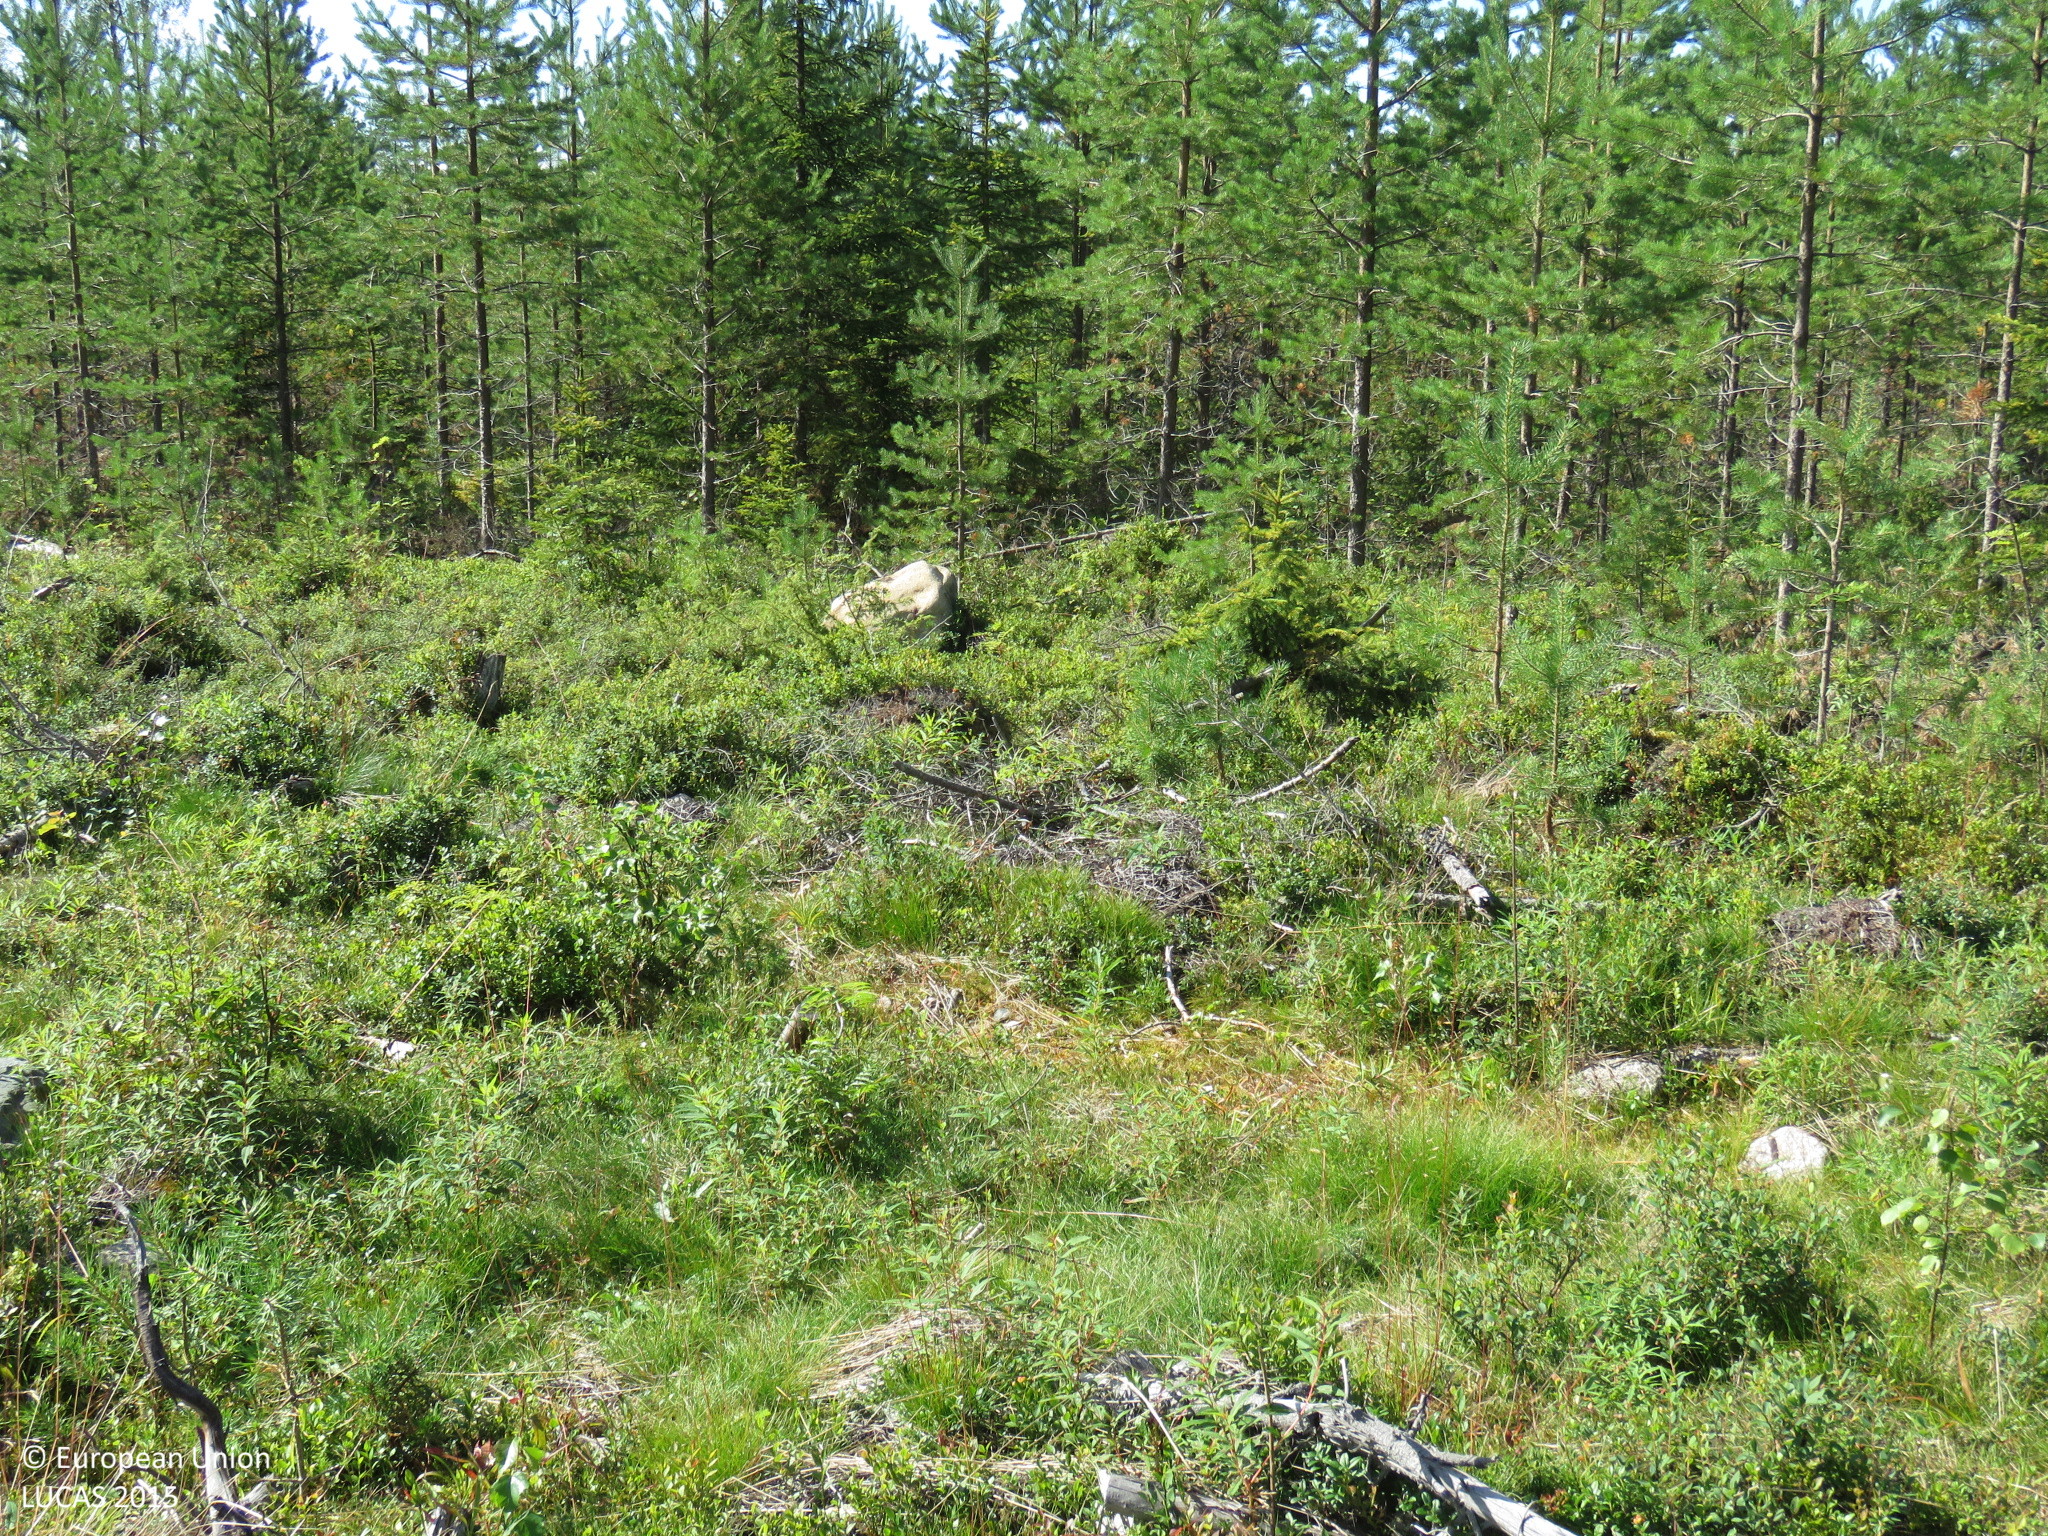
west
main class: Woodland
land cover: Other mixed woodland
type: boreal forest
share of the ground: 25 - 50 %
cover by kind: shrubs 40 %, coniferous forest trees 20 %, herbaceous plants 20 %, broadleaved forest trees 10 %, unconsolidated bare surface 10 %
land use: Forestry
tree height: < 5 m
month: August
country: FI
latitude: 65.2245
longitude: 26.0259
